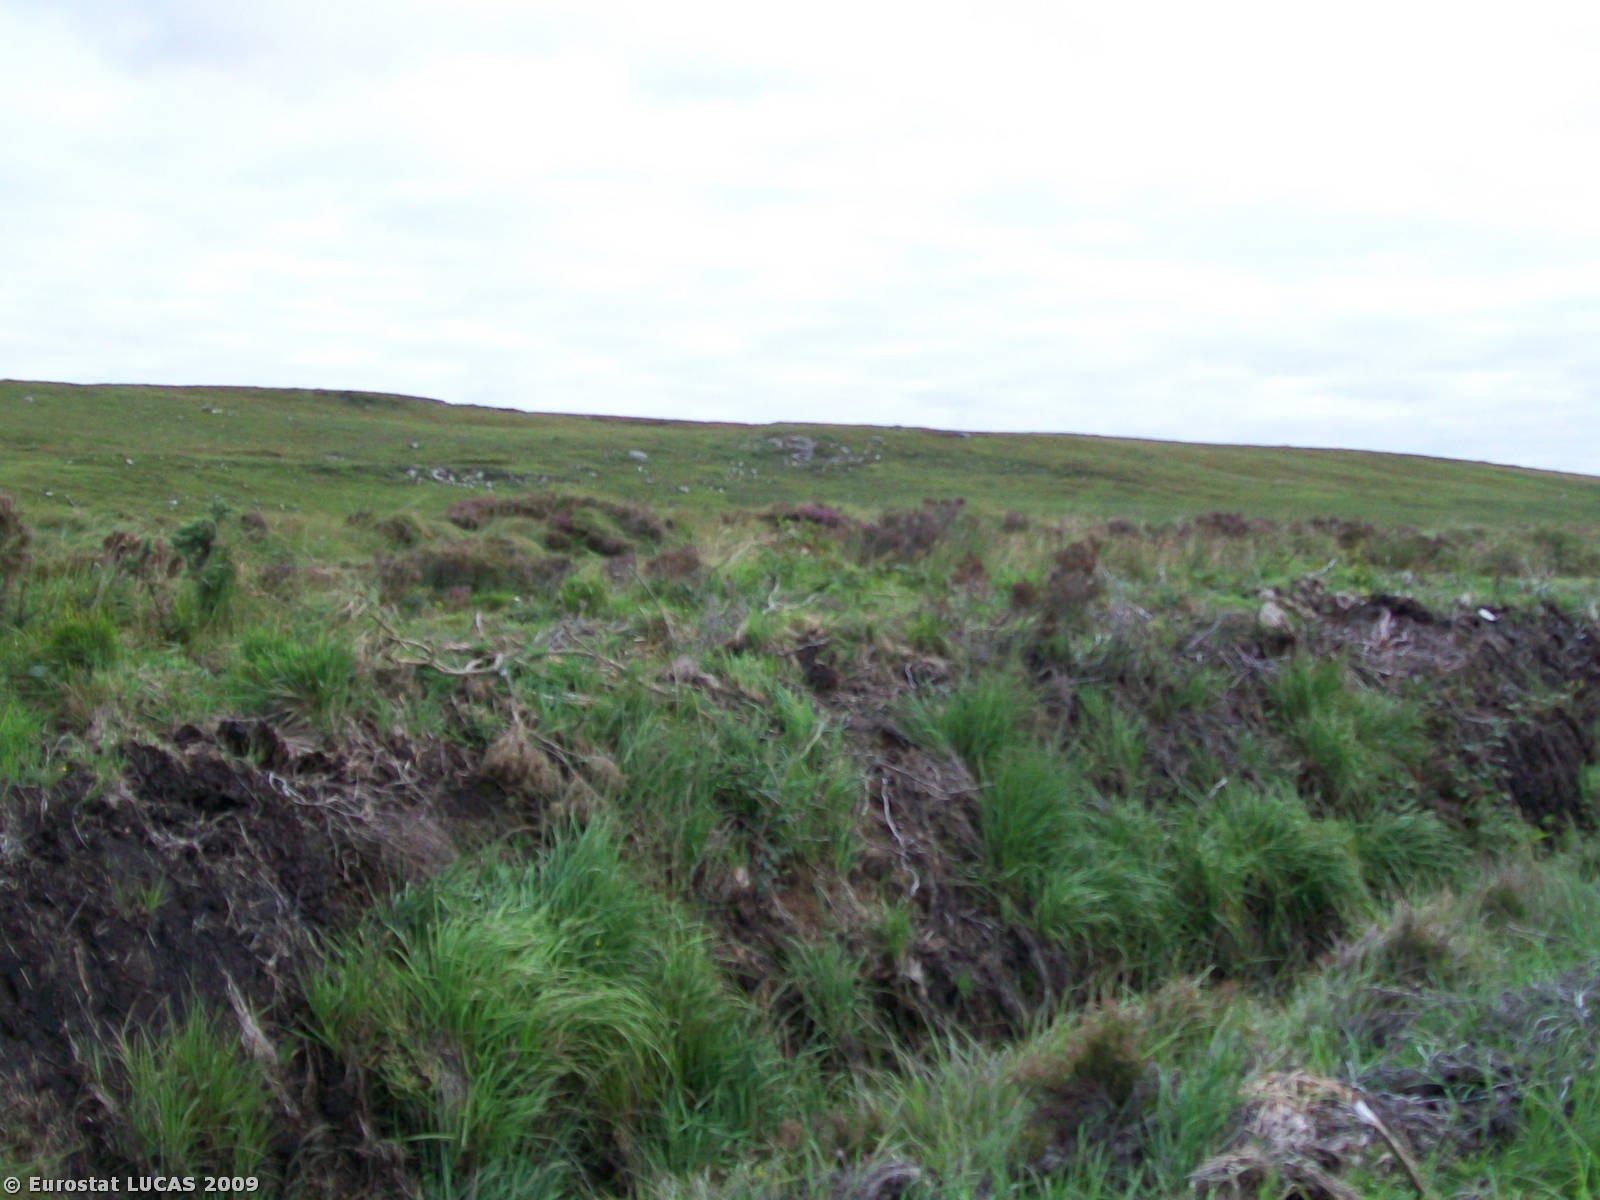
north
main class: Wetlands
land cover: Peatbogs
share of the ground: > 75 %
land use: Mining and quarrying
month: August
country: IE
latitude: 52.7554
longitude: -9.1705
